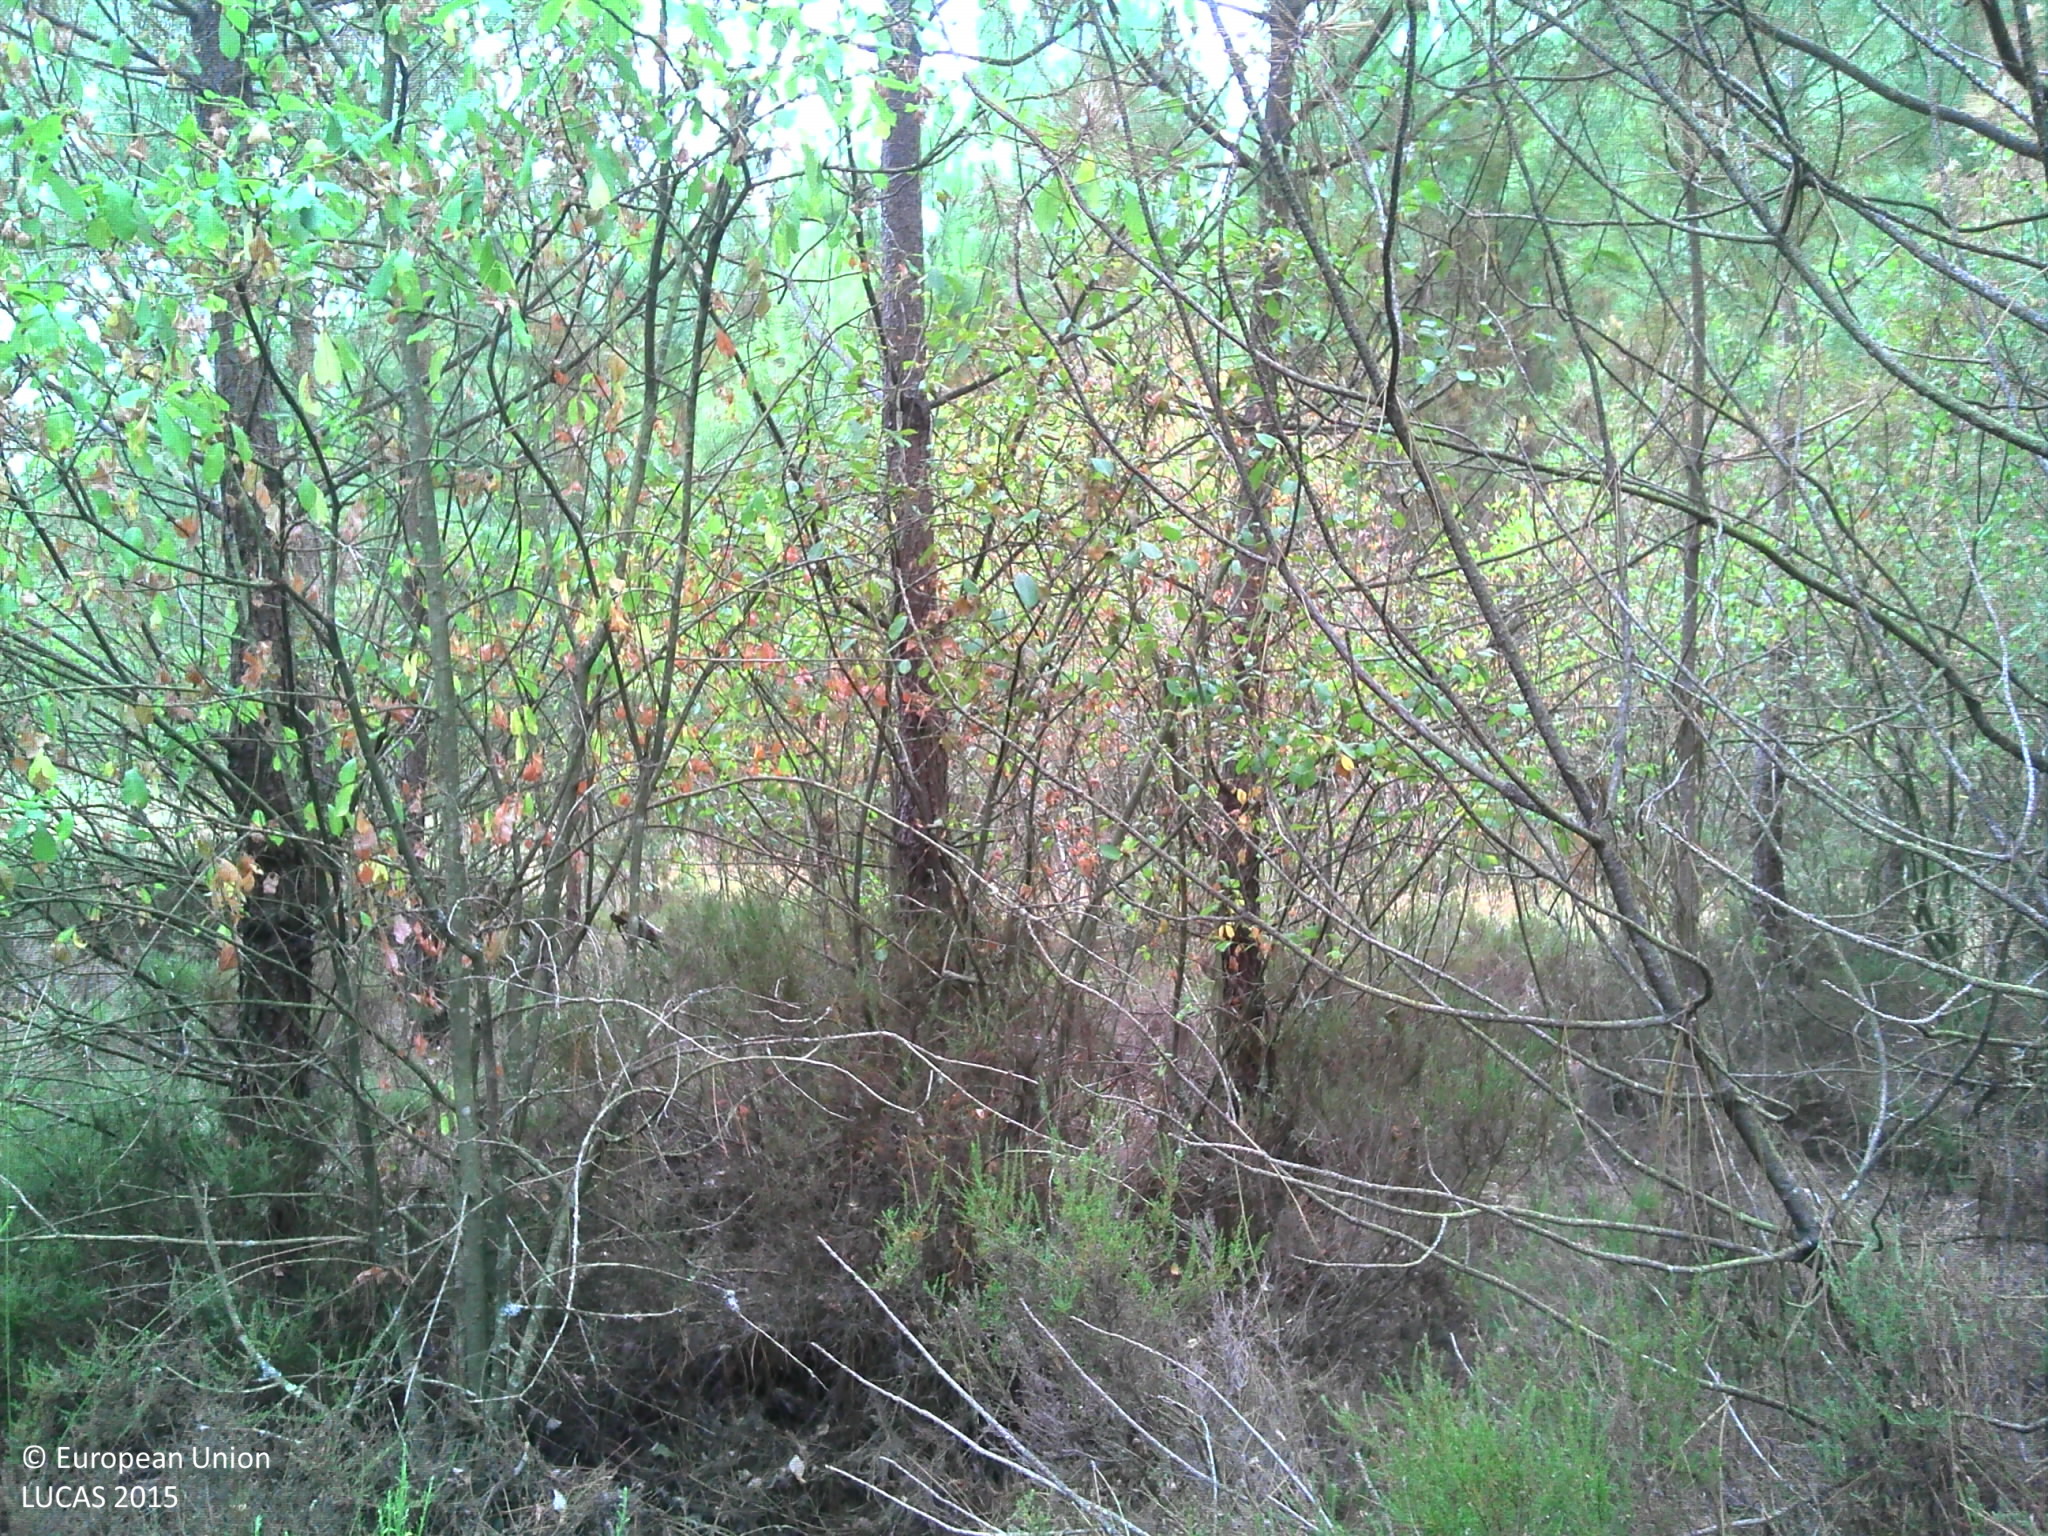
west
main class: Woodland
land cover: Pine dominated coniferous woodland
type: exotic forest
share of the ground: > 75 %
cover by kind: coniferous forest trees 70 %, shrubs 15 %, herbaceous plants 15 %
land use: Forestry
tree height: > 5 m
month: July
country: FR
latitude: 47.9240
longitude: 0.3263
